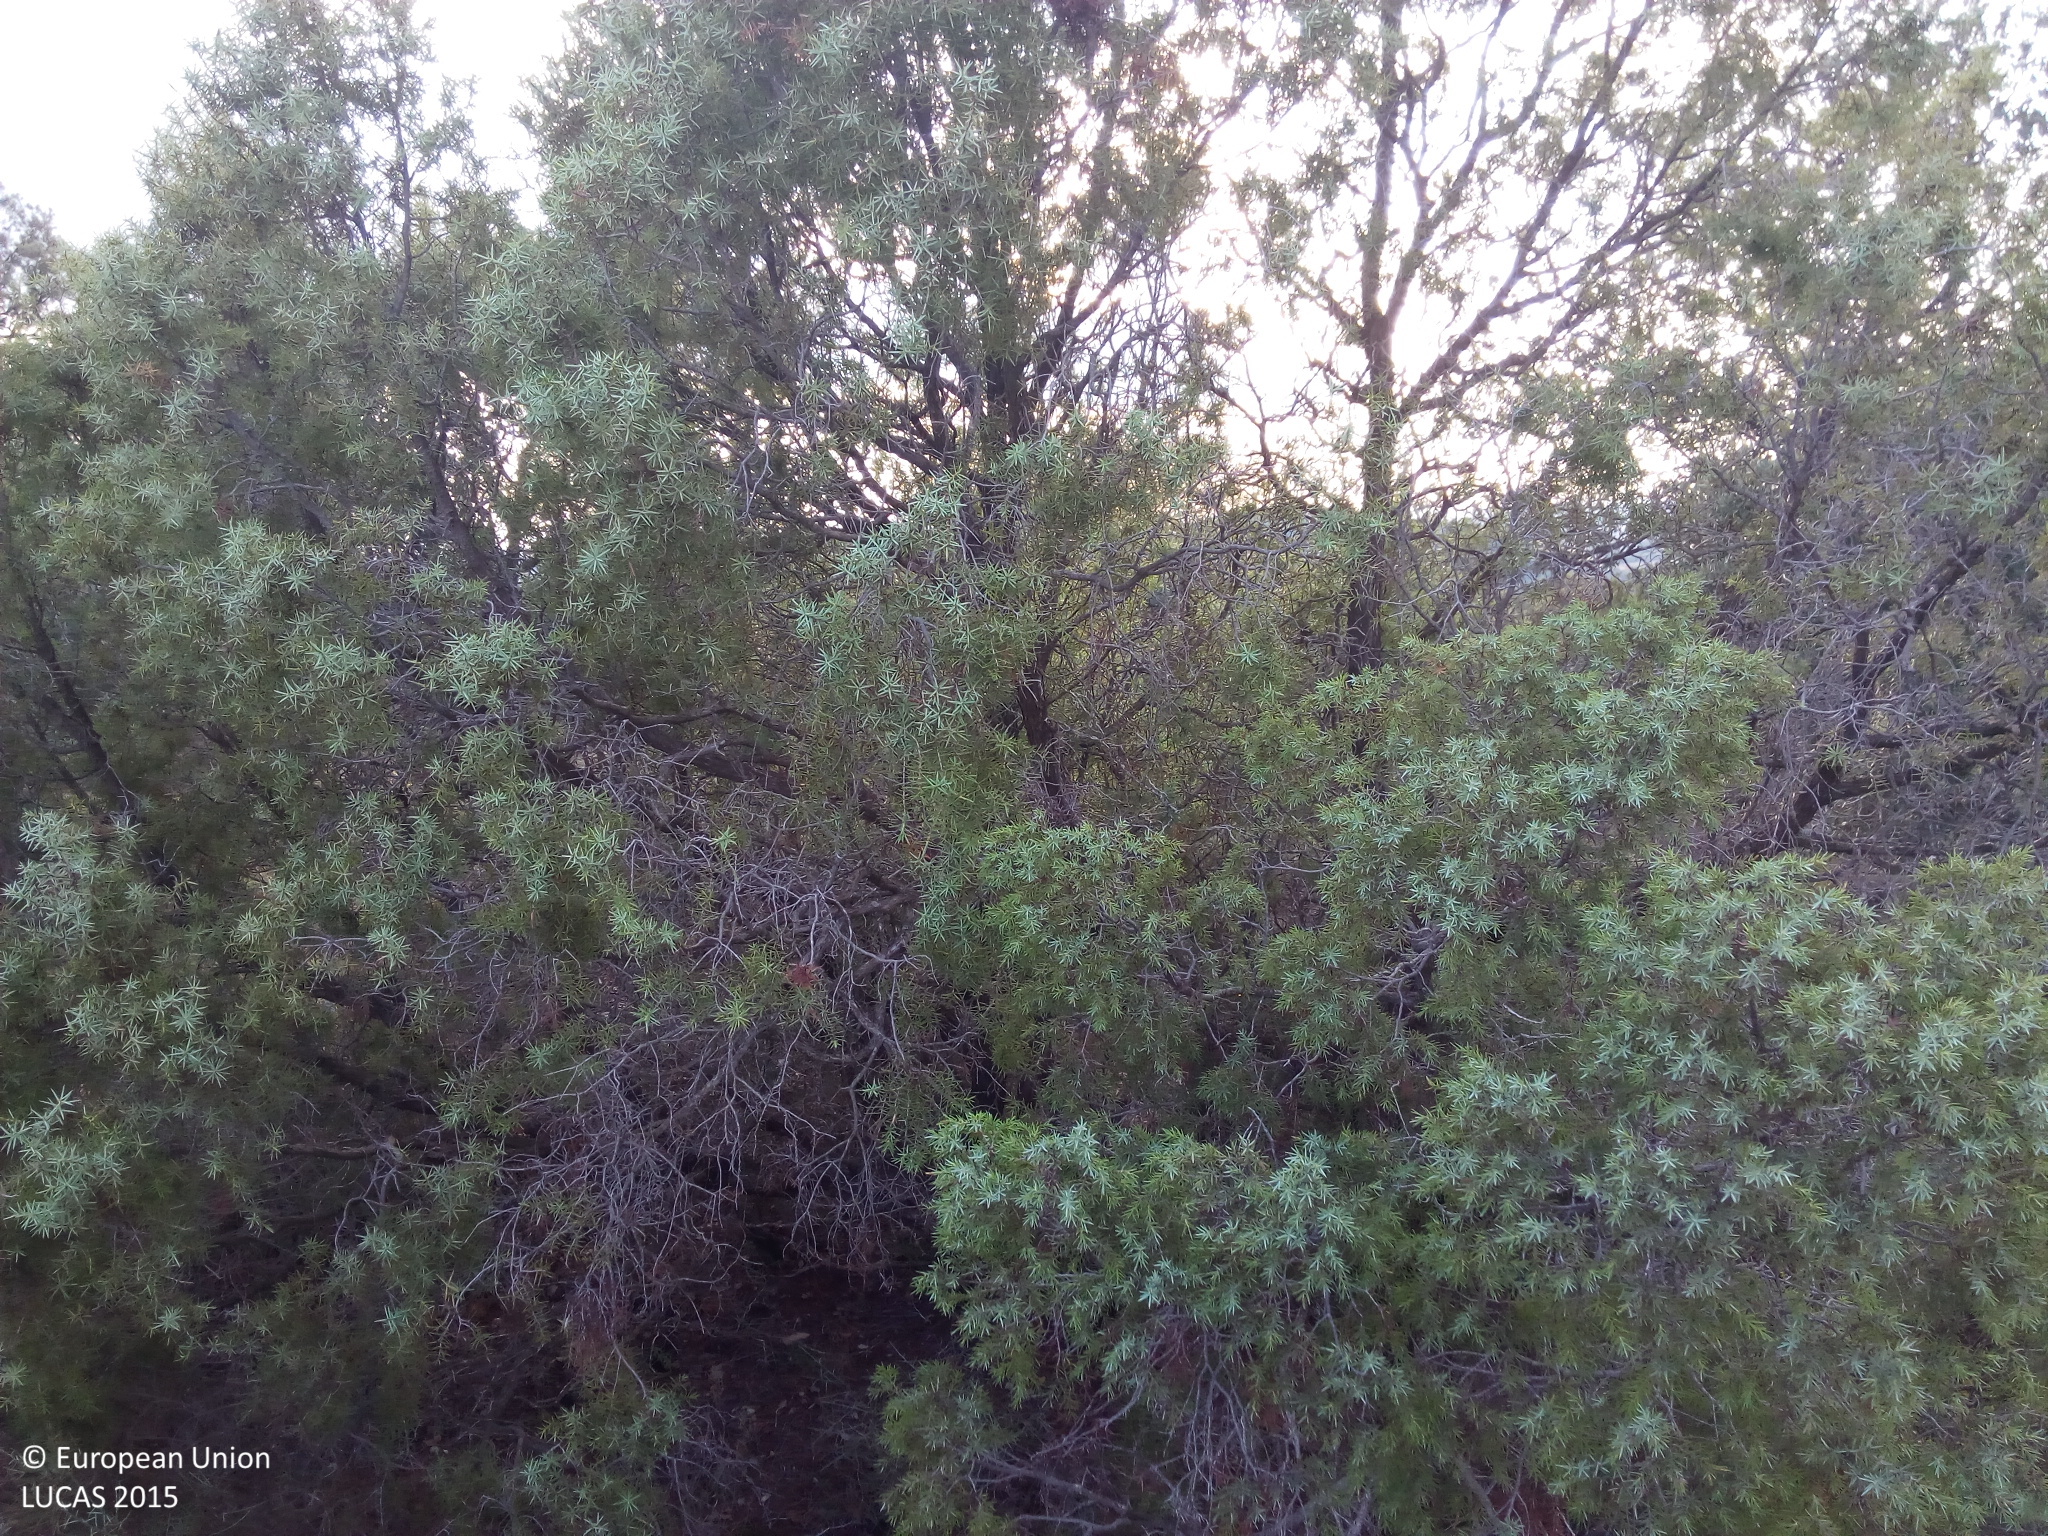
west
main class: Woodland
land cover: Broadleaved woodland
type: broadleaved evergreen forest
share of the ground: > 75 %
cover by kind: broadleaved forest trees 75 %, shrubs 10 %, herbaceous plants 10 %, consolidated bare surface 5 %
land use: Semi-natural and natural areas not in use
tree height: < 5 m
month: September
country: ES
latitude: 41.9779
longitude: 0.3891
